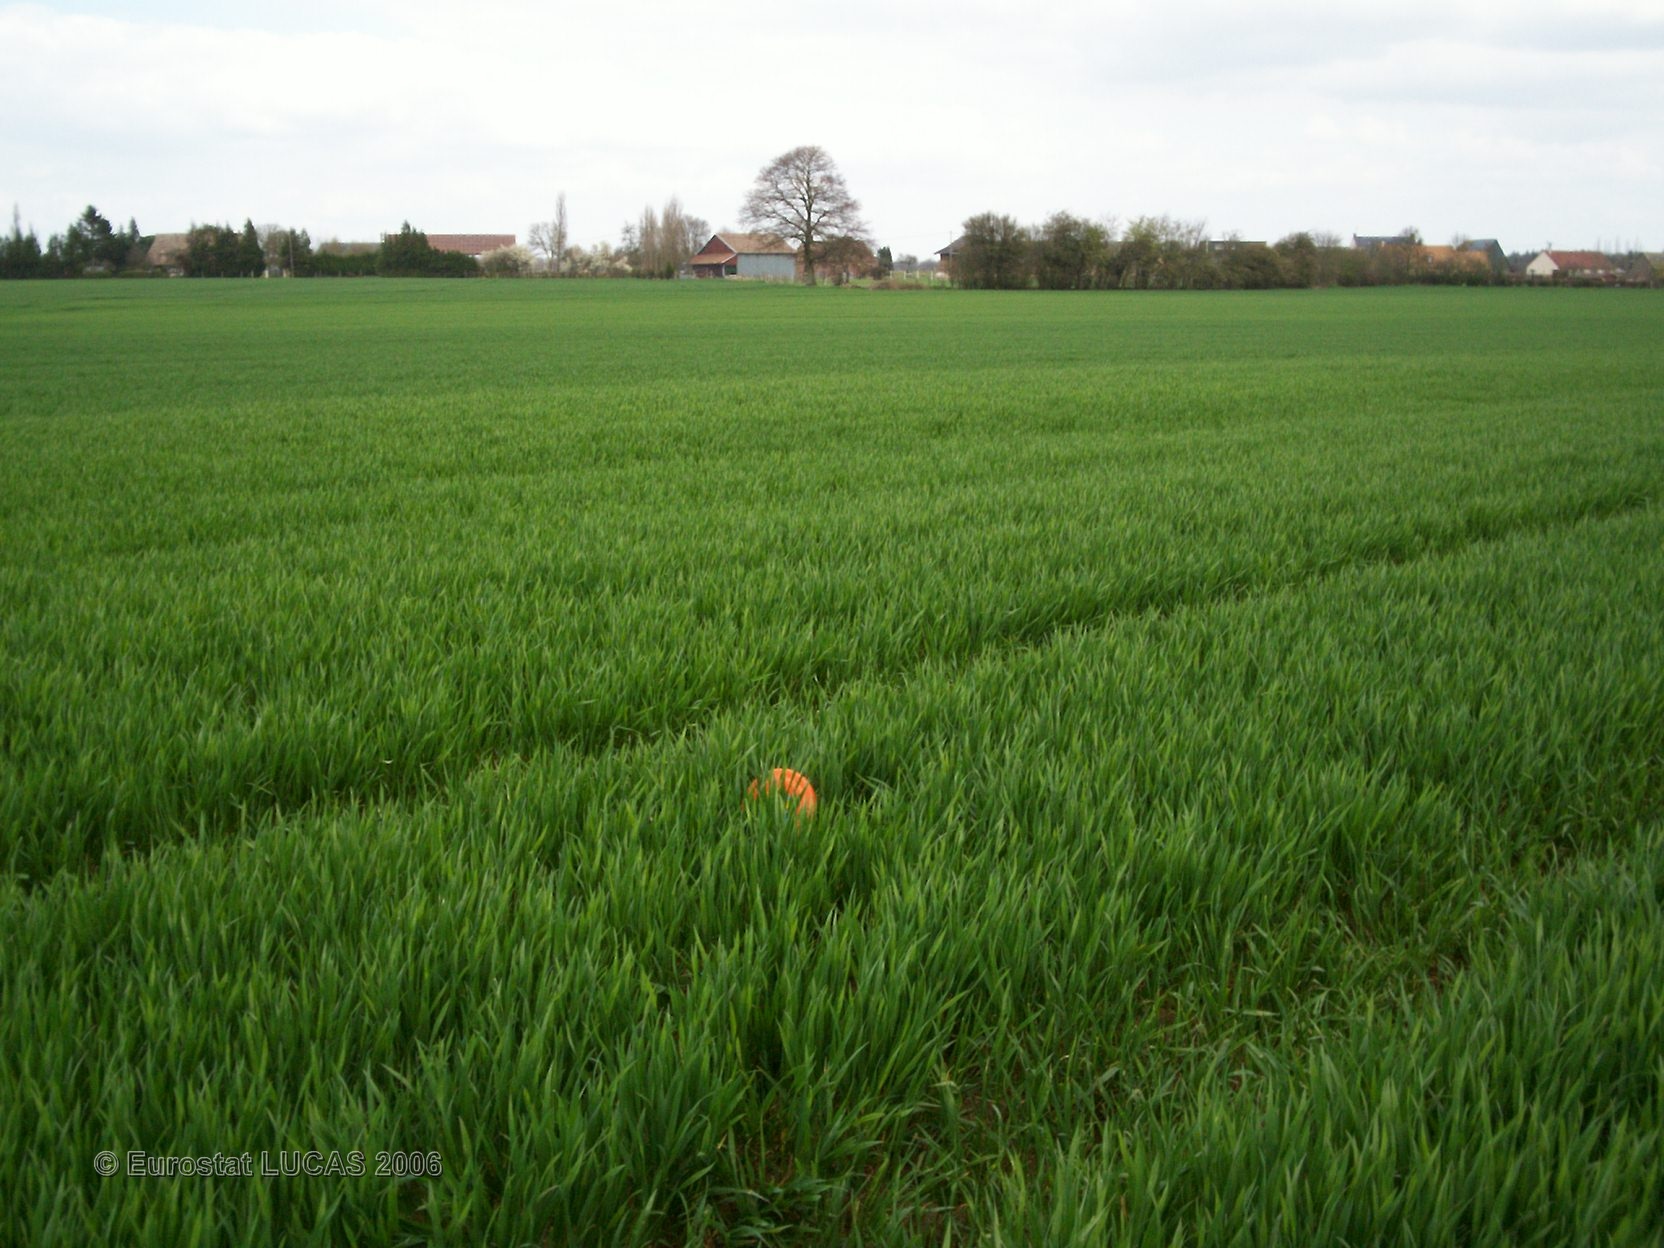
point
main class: Cropland
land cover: Common wheat
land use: Agriculture (excluding fallow land and kitchen gardens)
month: April
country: FR
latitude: 49.1244
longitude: 1.0303
